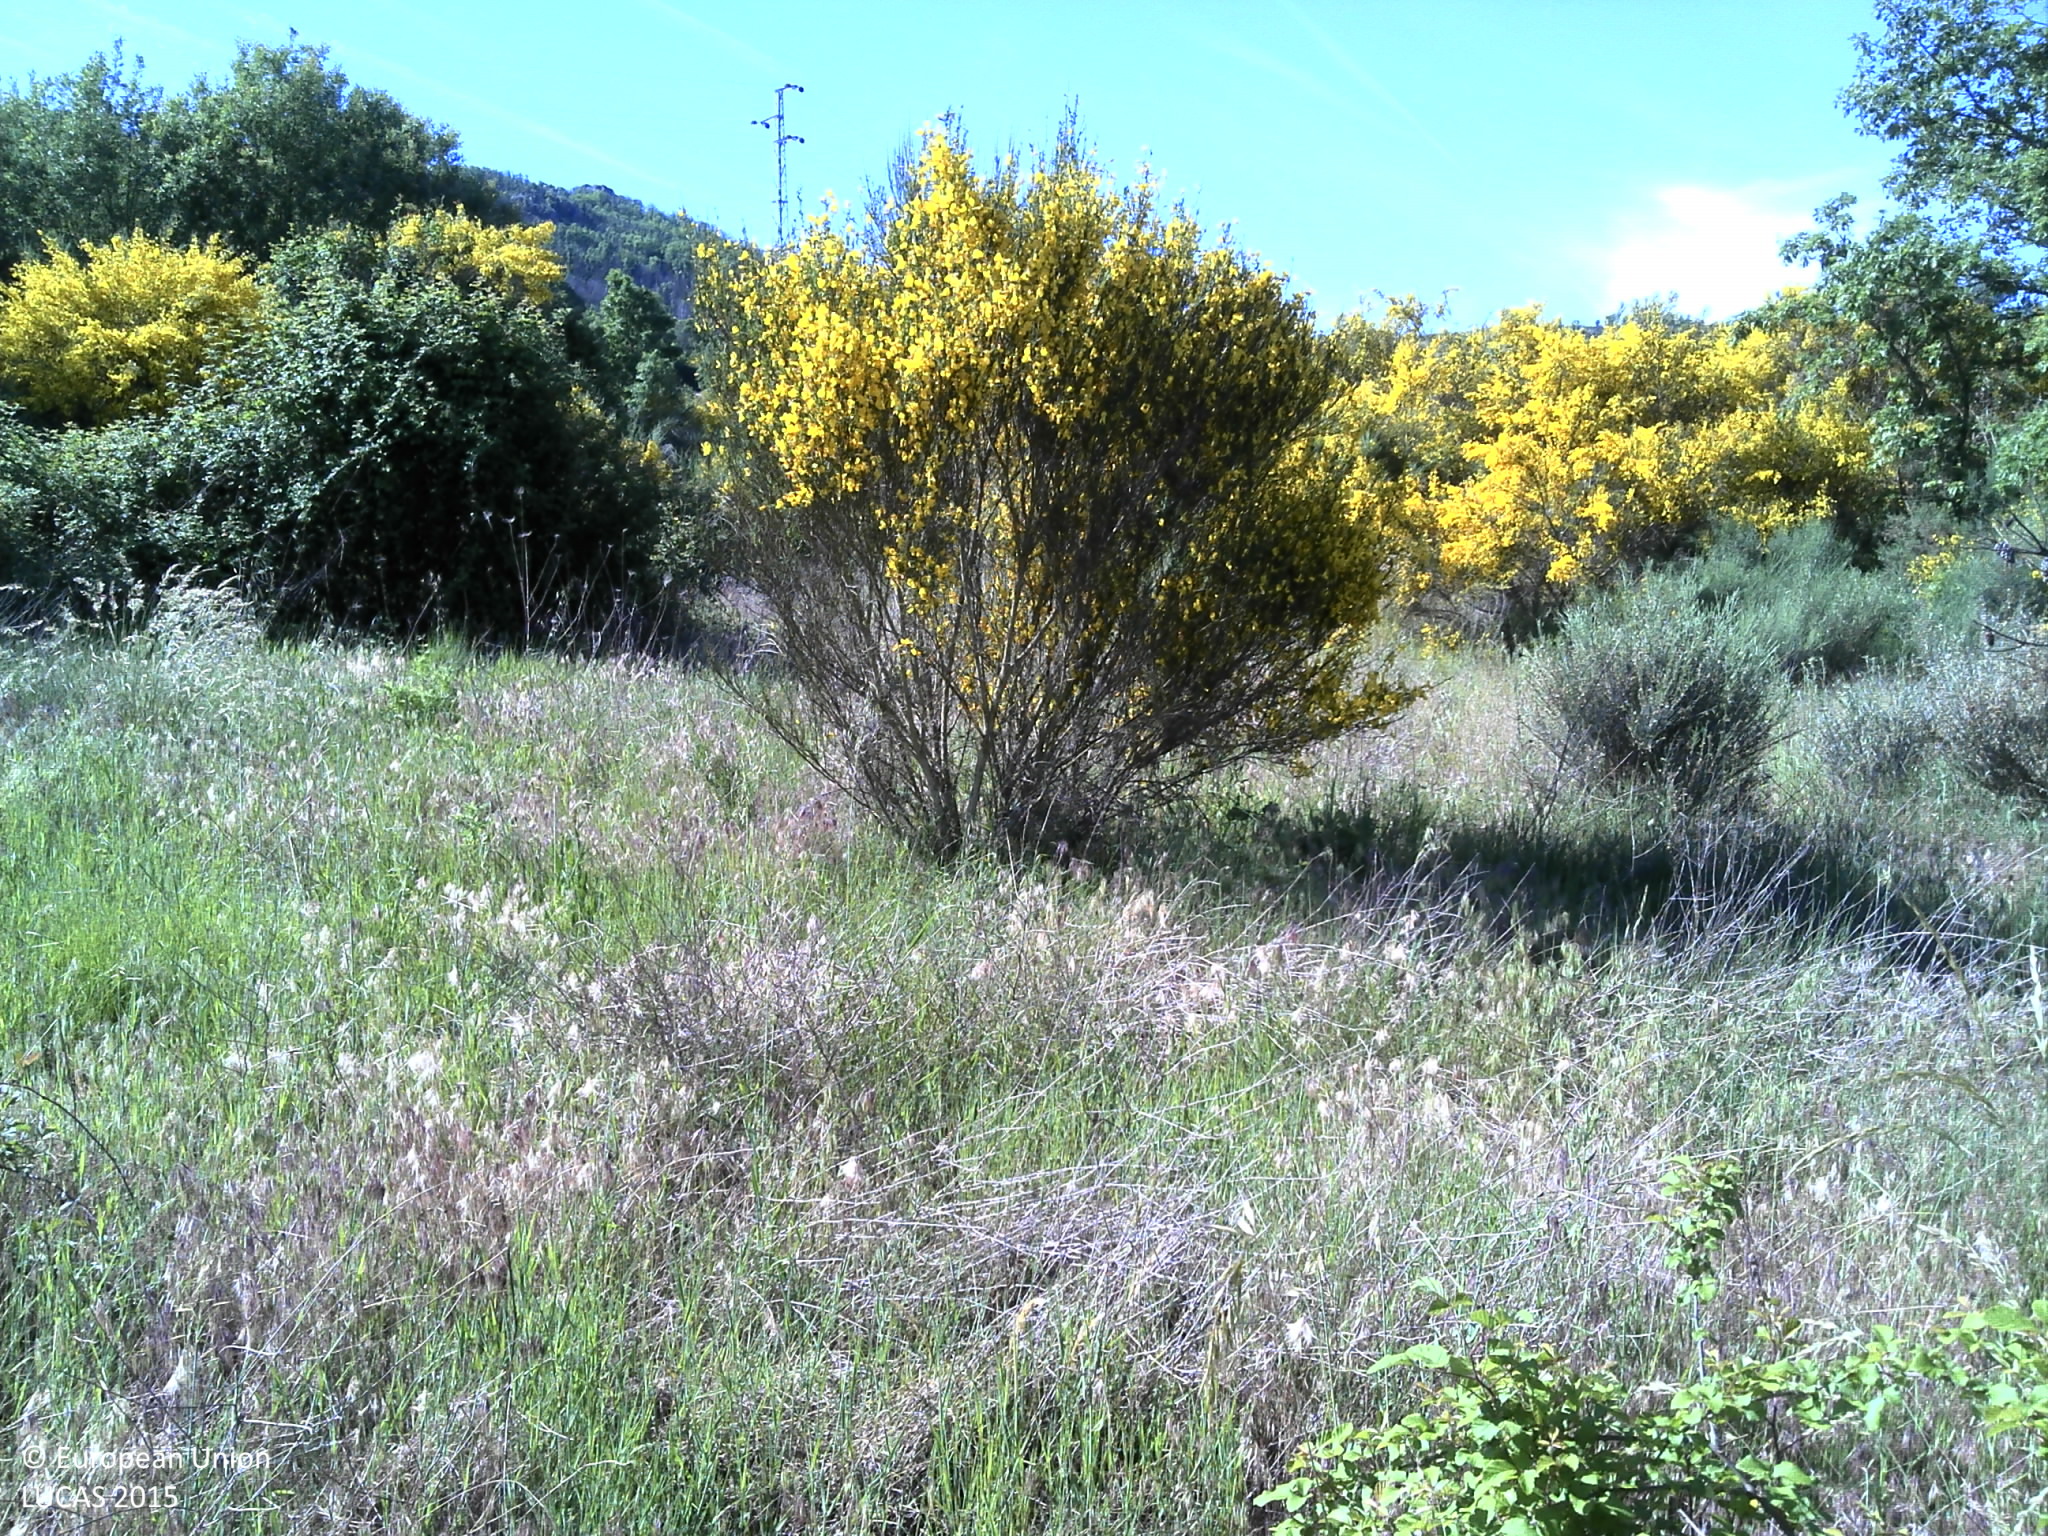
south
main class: Shrubland
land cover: Shrubland without tree cover
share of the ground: 25 - 50 %
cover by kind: herbaceous plants 70 %, shrubs 30 %
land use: Forestry
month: May
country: PT
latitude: 41.7671
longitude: -7.3654
